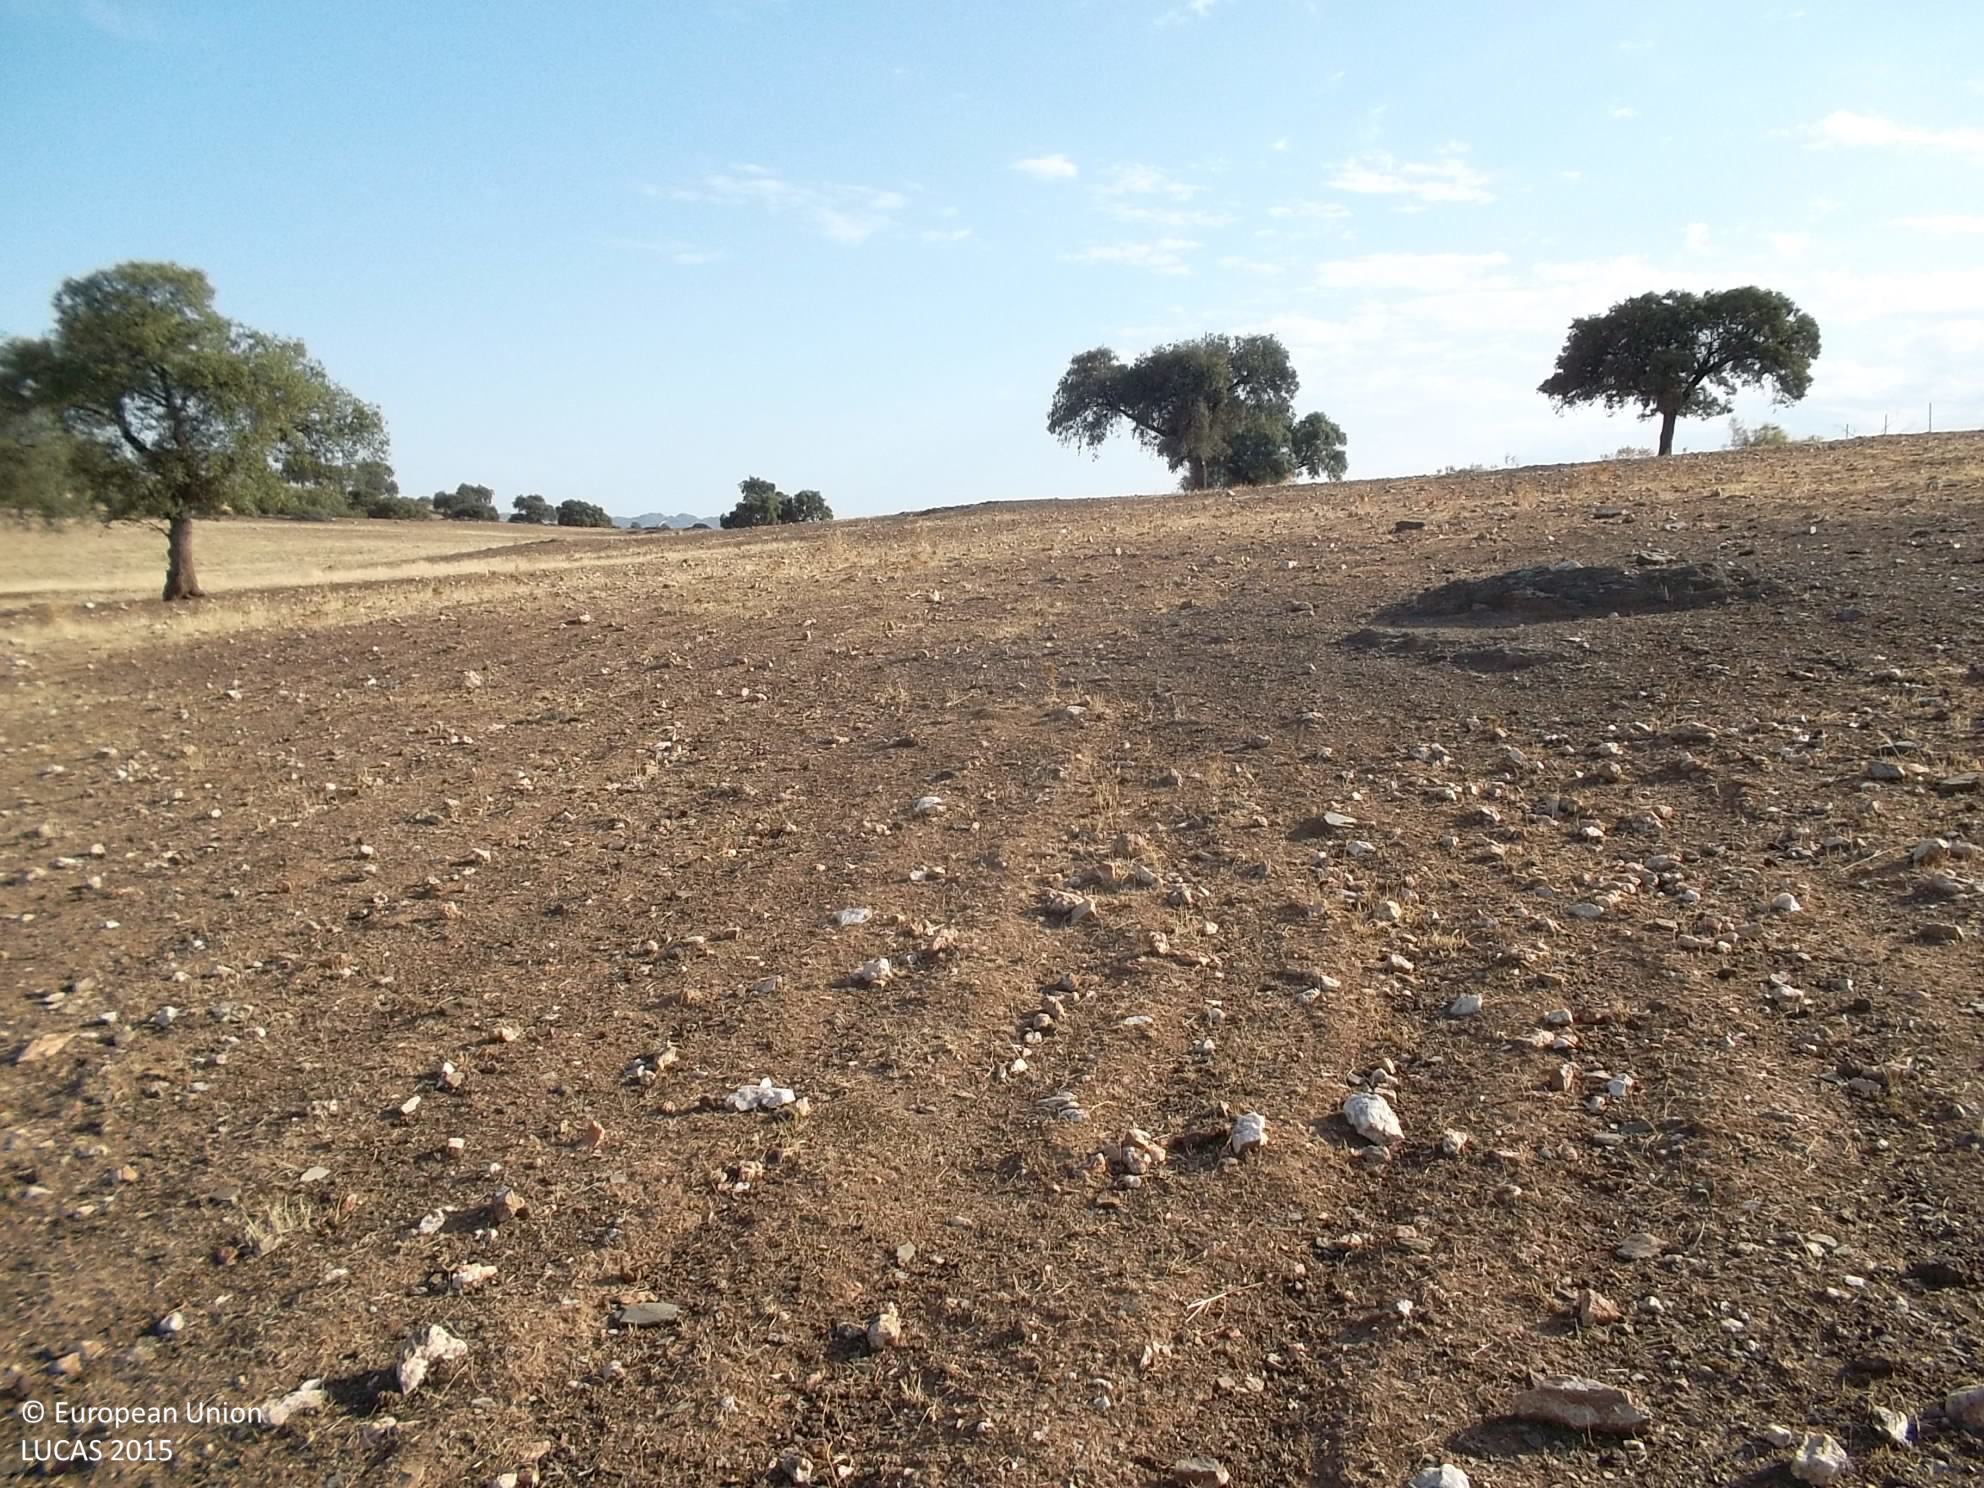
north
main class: Grassland
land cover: Grassland with sparse tree/shrub cover
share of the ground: > 75 %
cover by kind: herbaceous plants 95 %, broadleaved forest trees 5 %
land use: Agriculture (excluding fallow land and kitchen gardens)
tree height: > 5 m
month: July
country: ES
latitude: 38.5648
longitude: -5.4022
